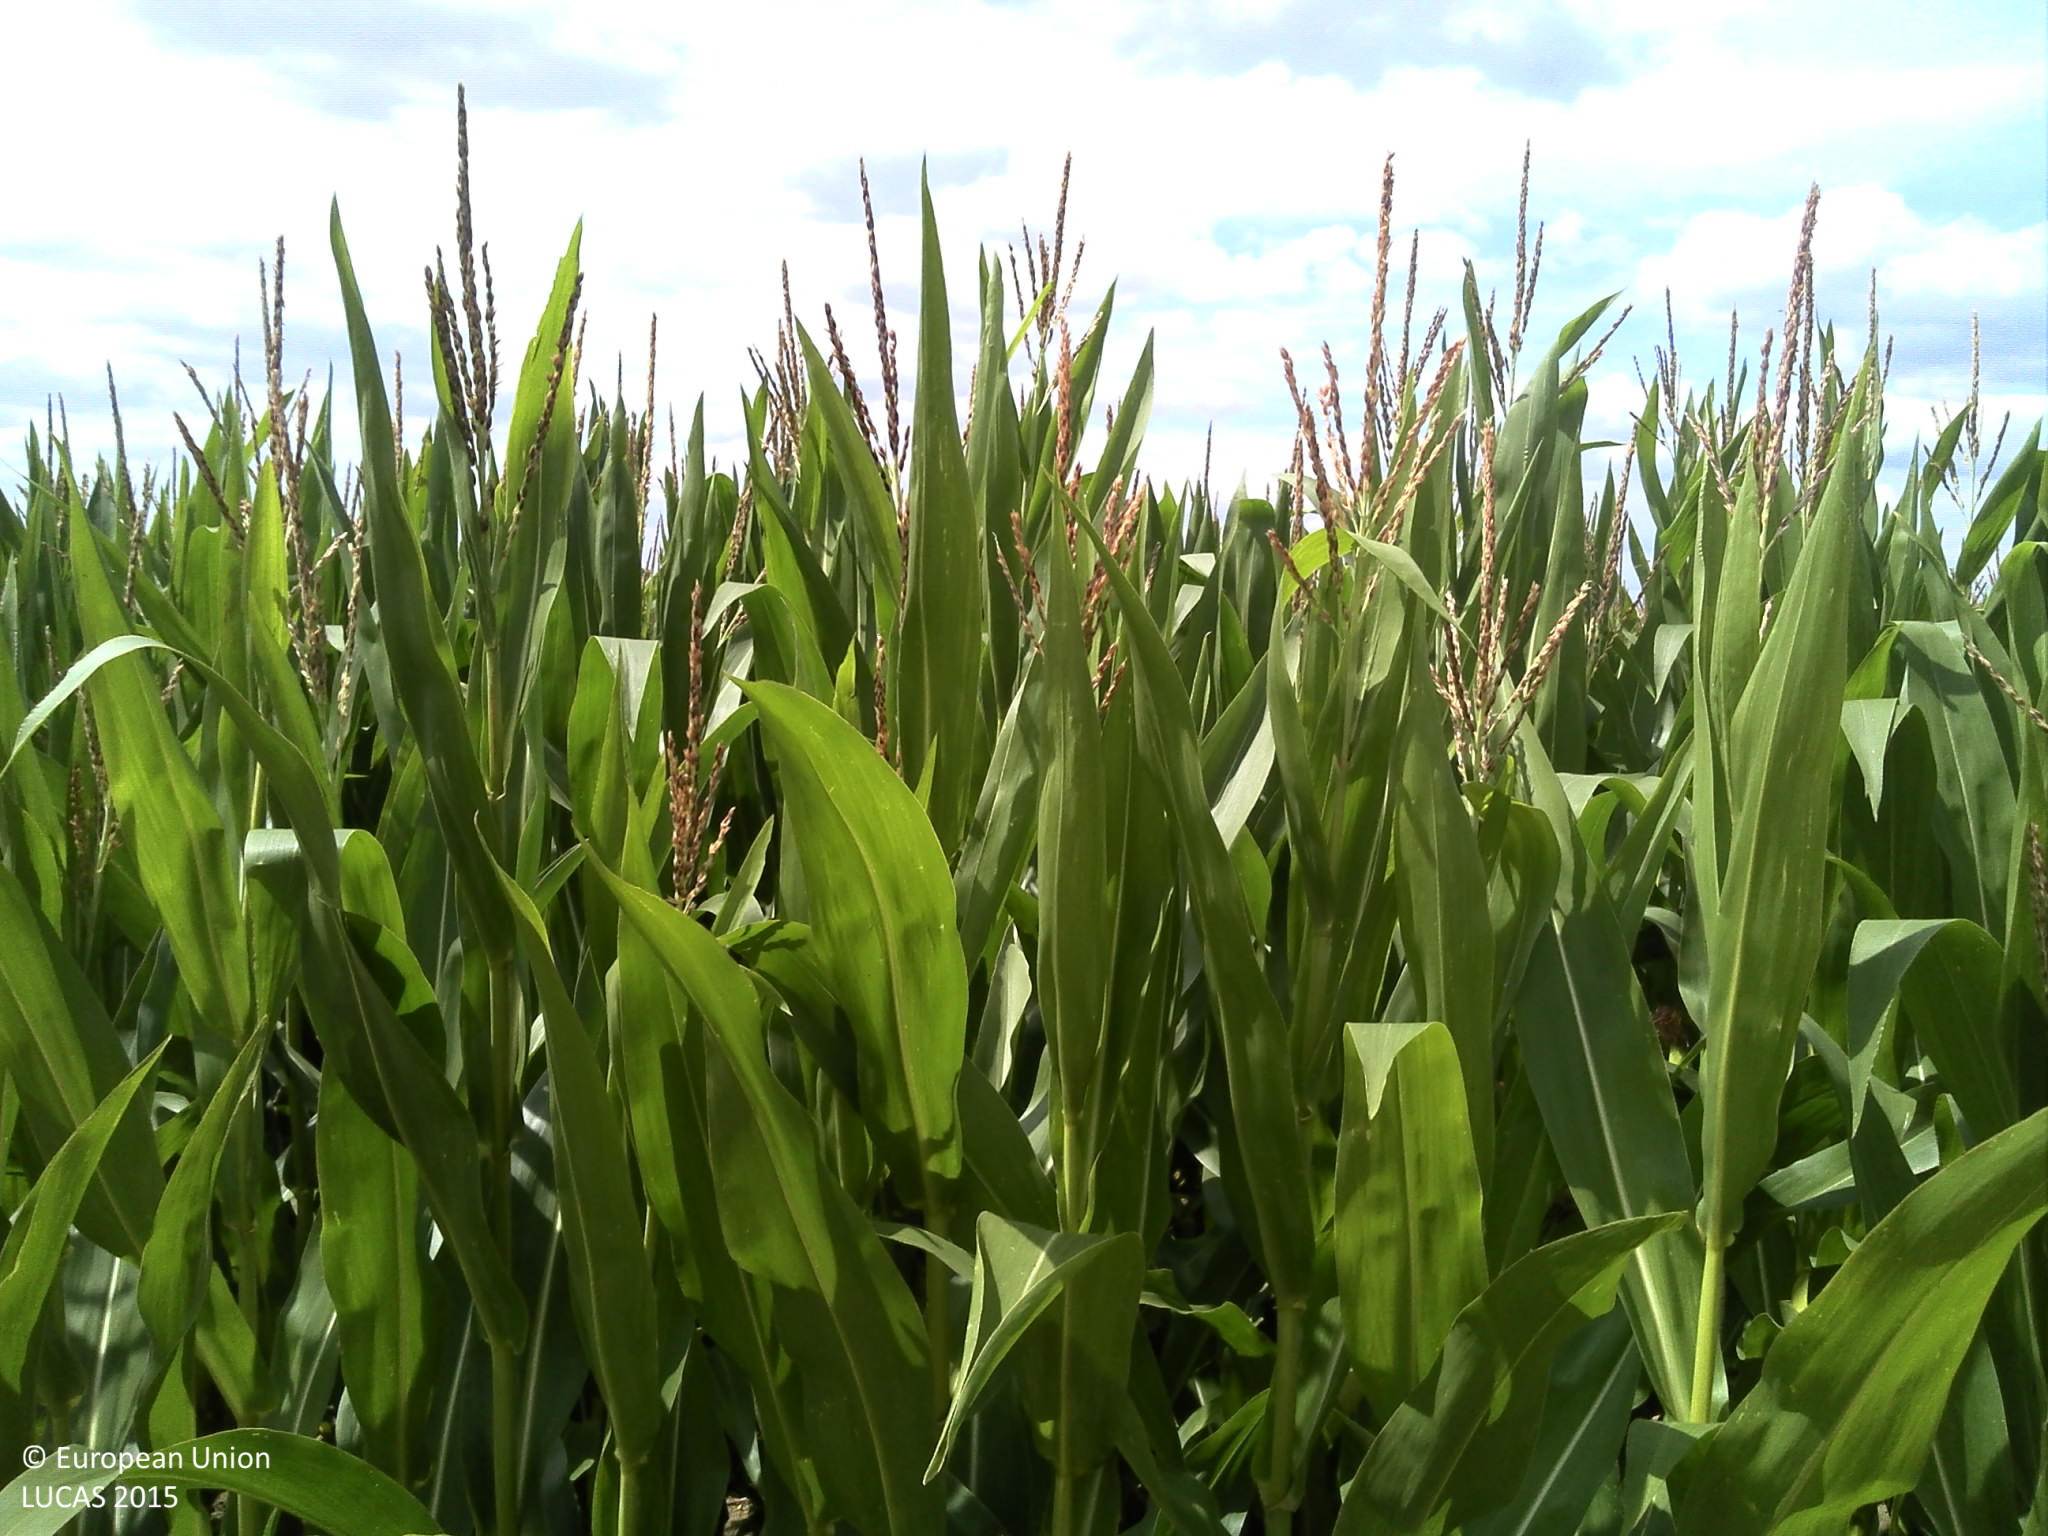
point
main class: Cropland
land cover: Maize
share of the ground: > 75 %
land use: Agriculture (excluding fallow land and kitchen gardens)
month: July
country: FR
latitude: 49.5831
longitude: 4.5051
